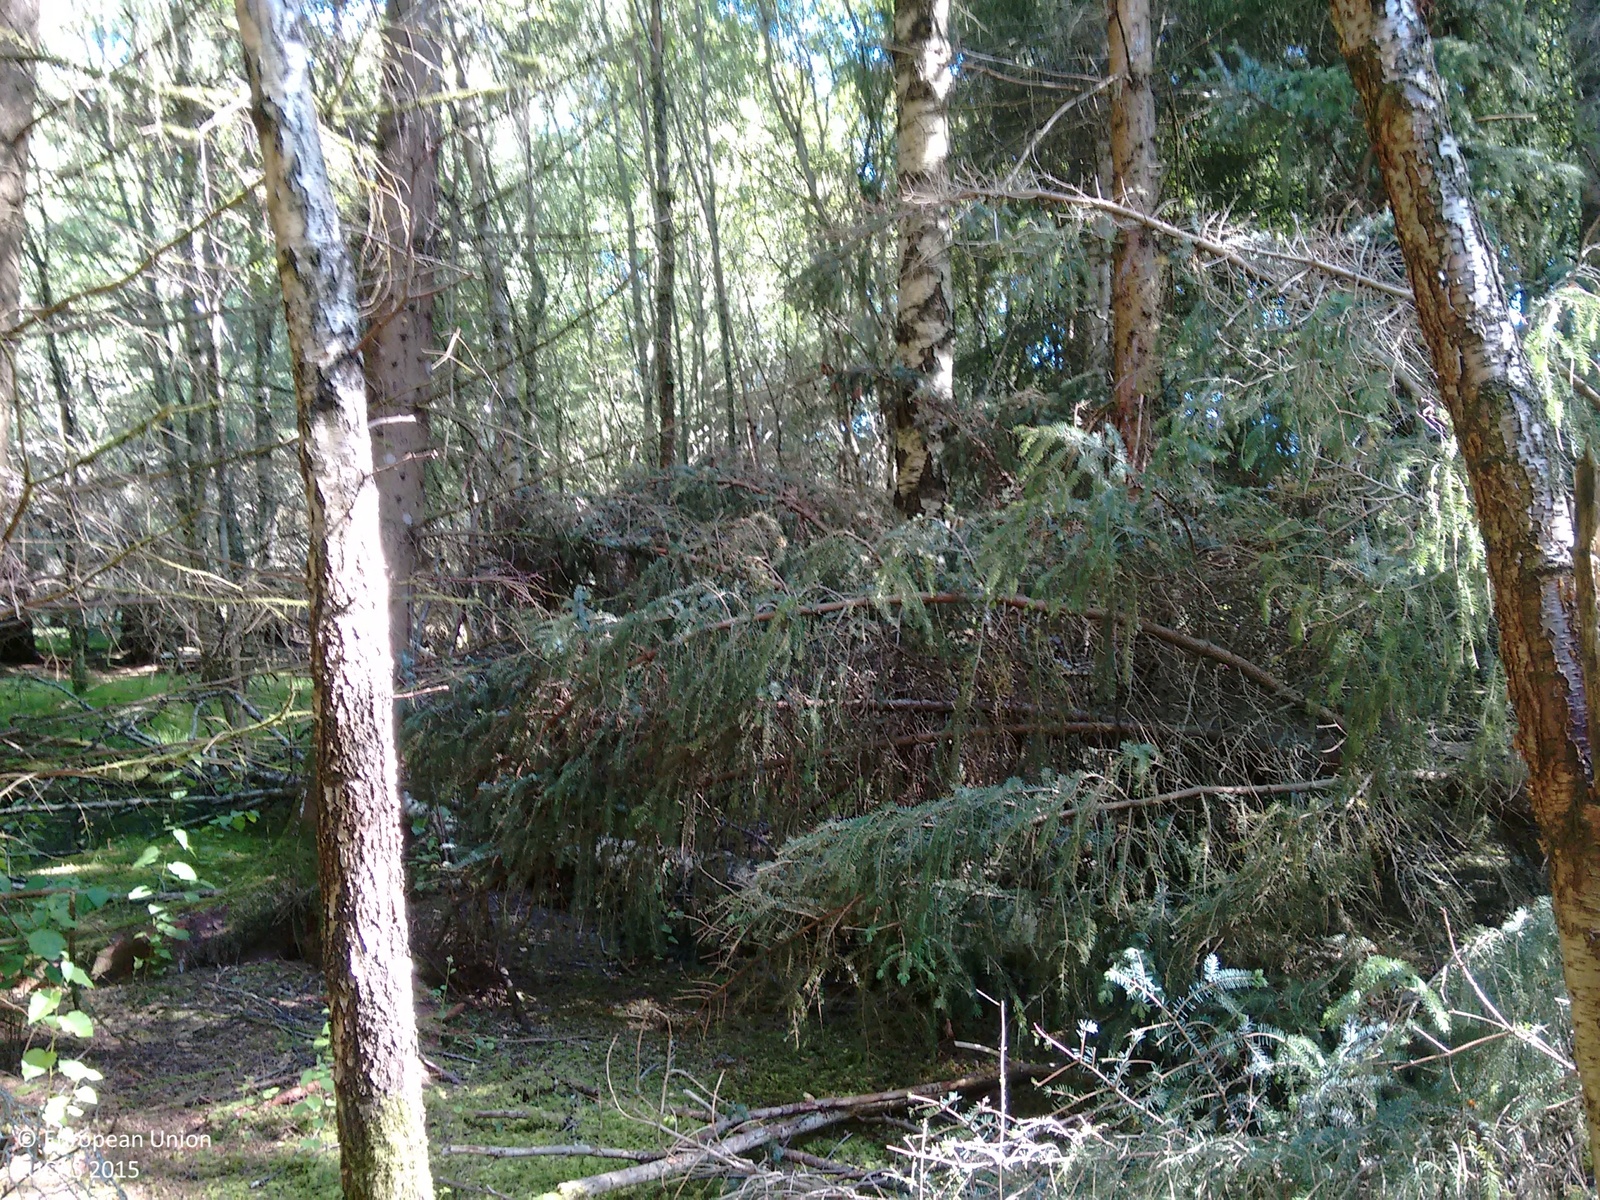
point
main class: Woodland
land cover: Spruce dominated mixed woodland
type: exotic forest
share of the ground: > 75 %
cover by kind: coniferous forest trees 70 %, broadleaved forest trees 30 %
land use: Forestry
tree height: > 5 m
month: August
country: GB
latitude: 57.7515
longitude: -4.0431
